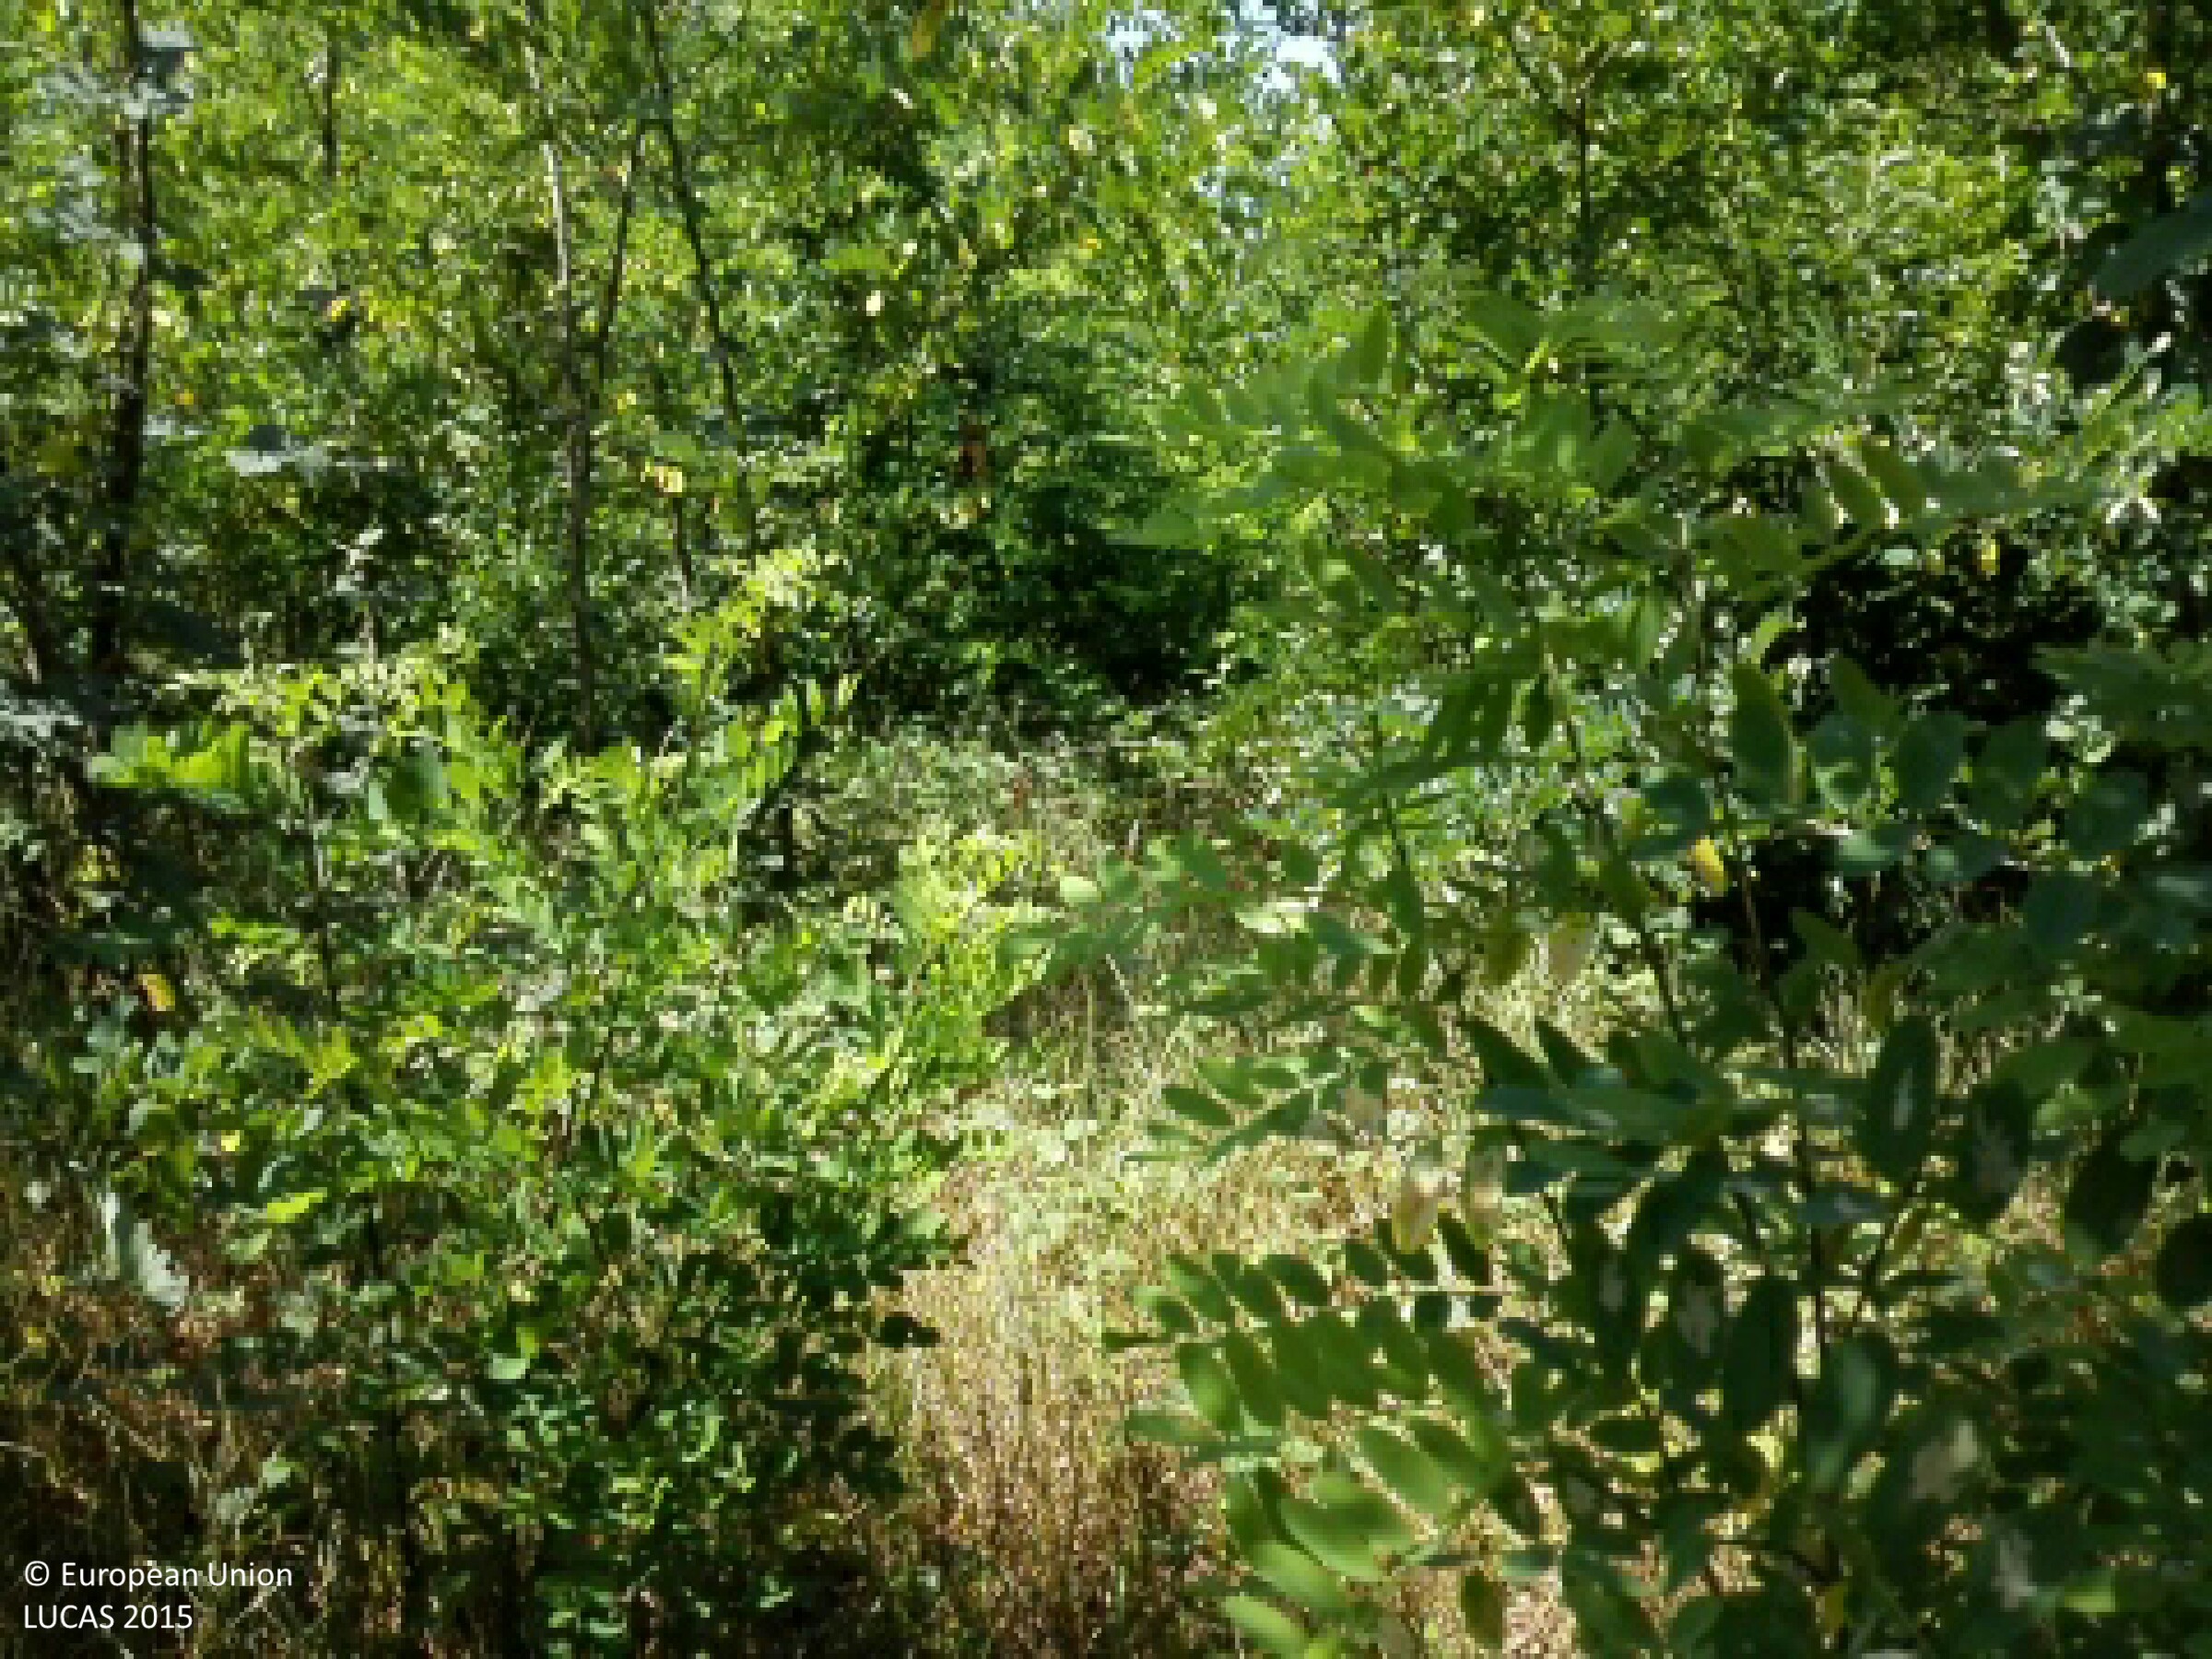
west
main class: Woodland
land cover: Broadleaved woodland
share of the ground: > 75 %
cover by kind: broadleaved forest trees 70 %, shrubs 25 %, herbaceous plants 5 %
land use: Semi-natural and natural areas not in use
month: July
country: HU
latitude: 47.6559
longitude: 21.6694
